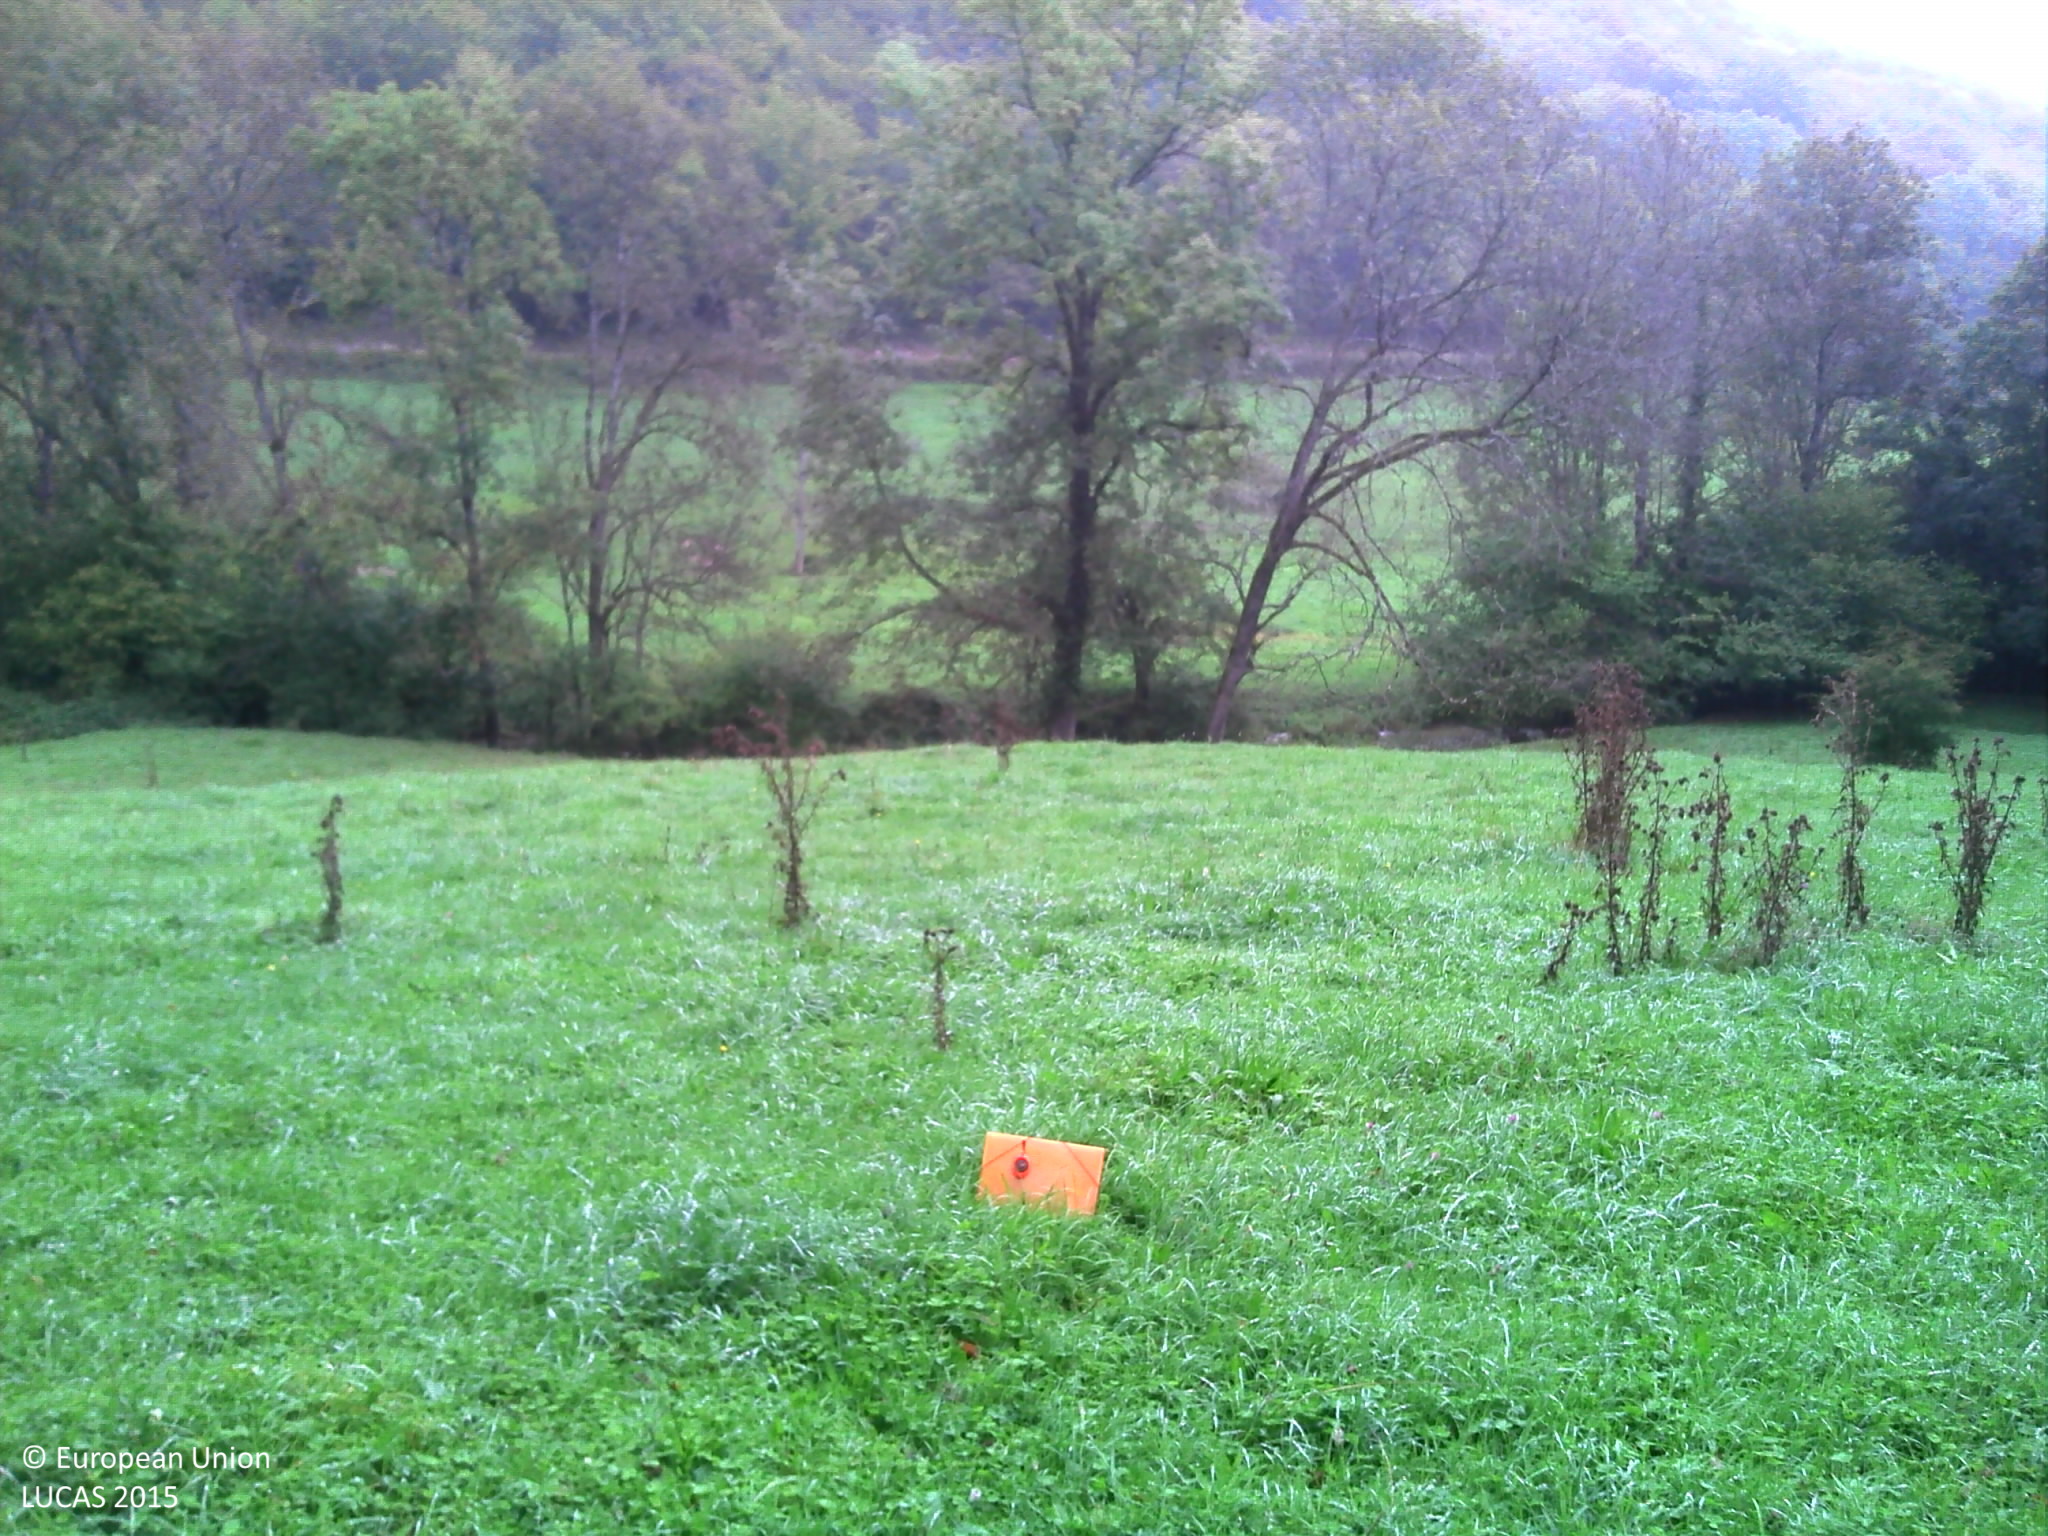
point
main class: Grassland
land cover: Grassland without tree/shrub cover
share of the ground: > 75 %
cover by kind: herbaceous plants 100 %
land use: Agriculture (excluding fallow land and kitchen gardens)
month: September
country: FR
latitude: 47.0895
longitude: 4.7708
